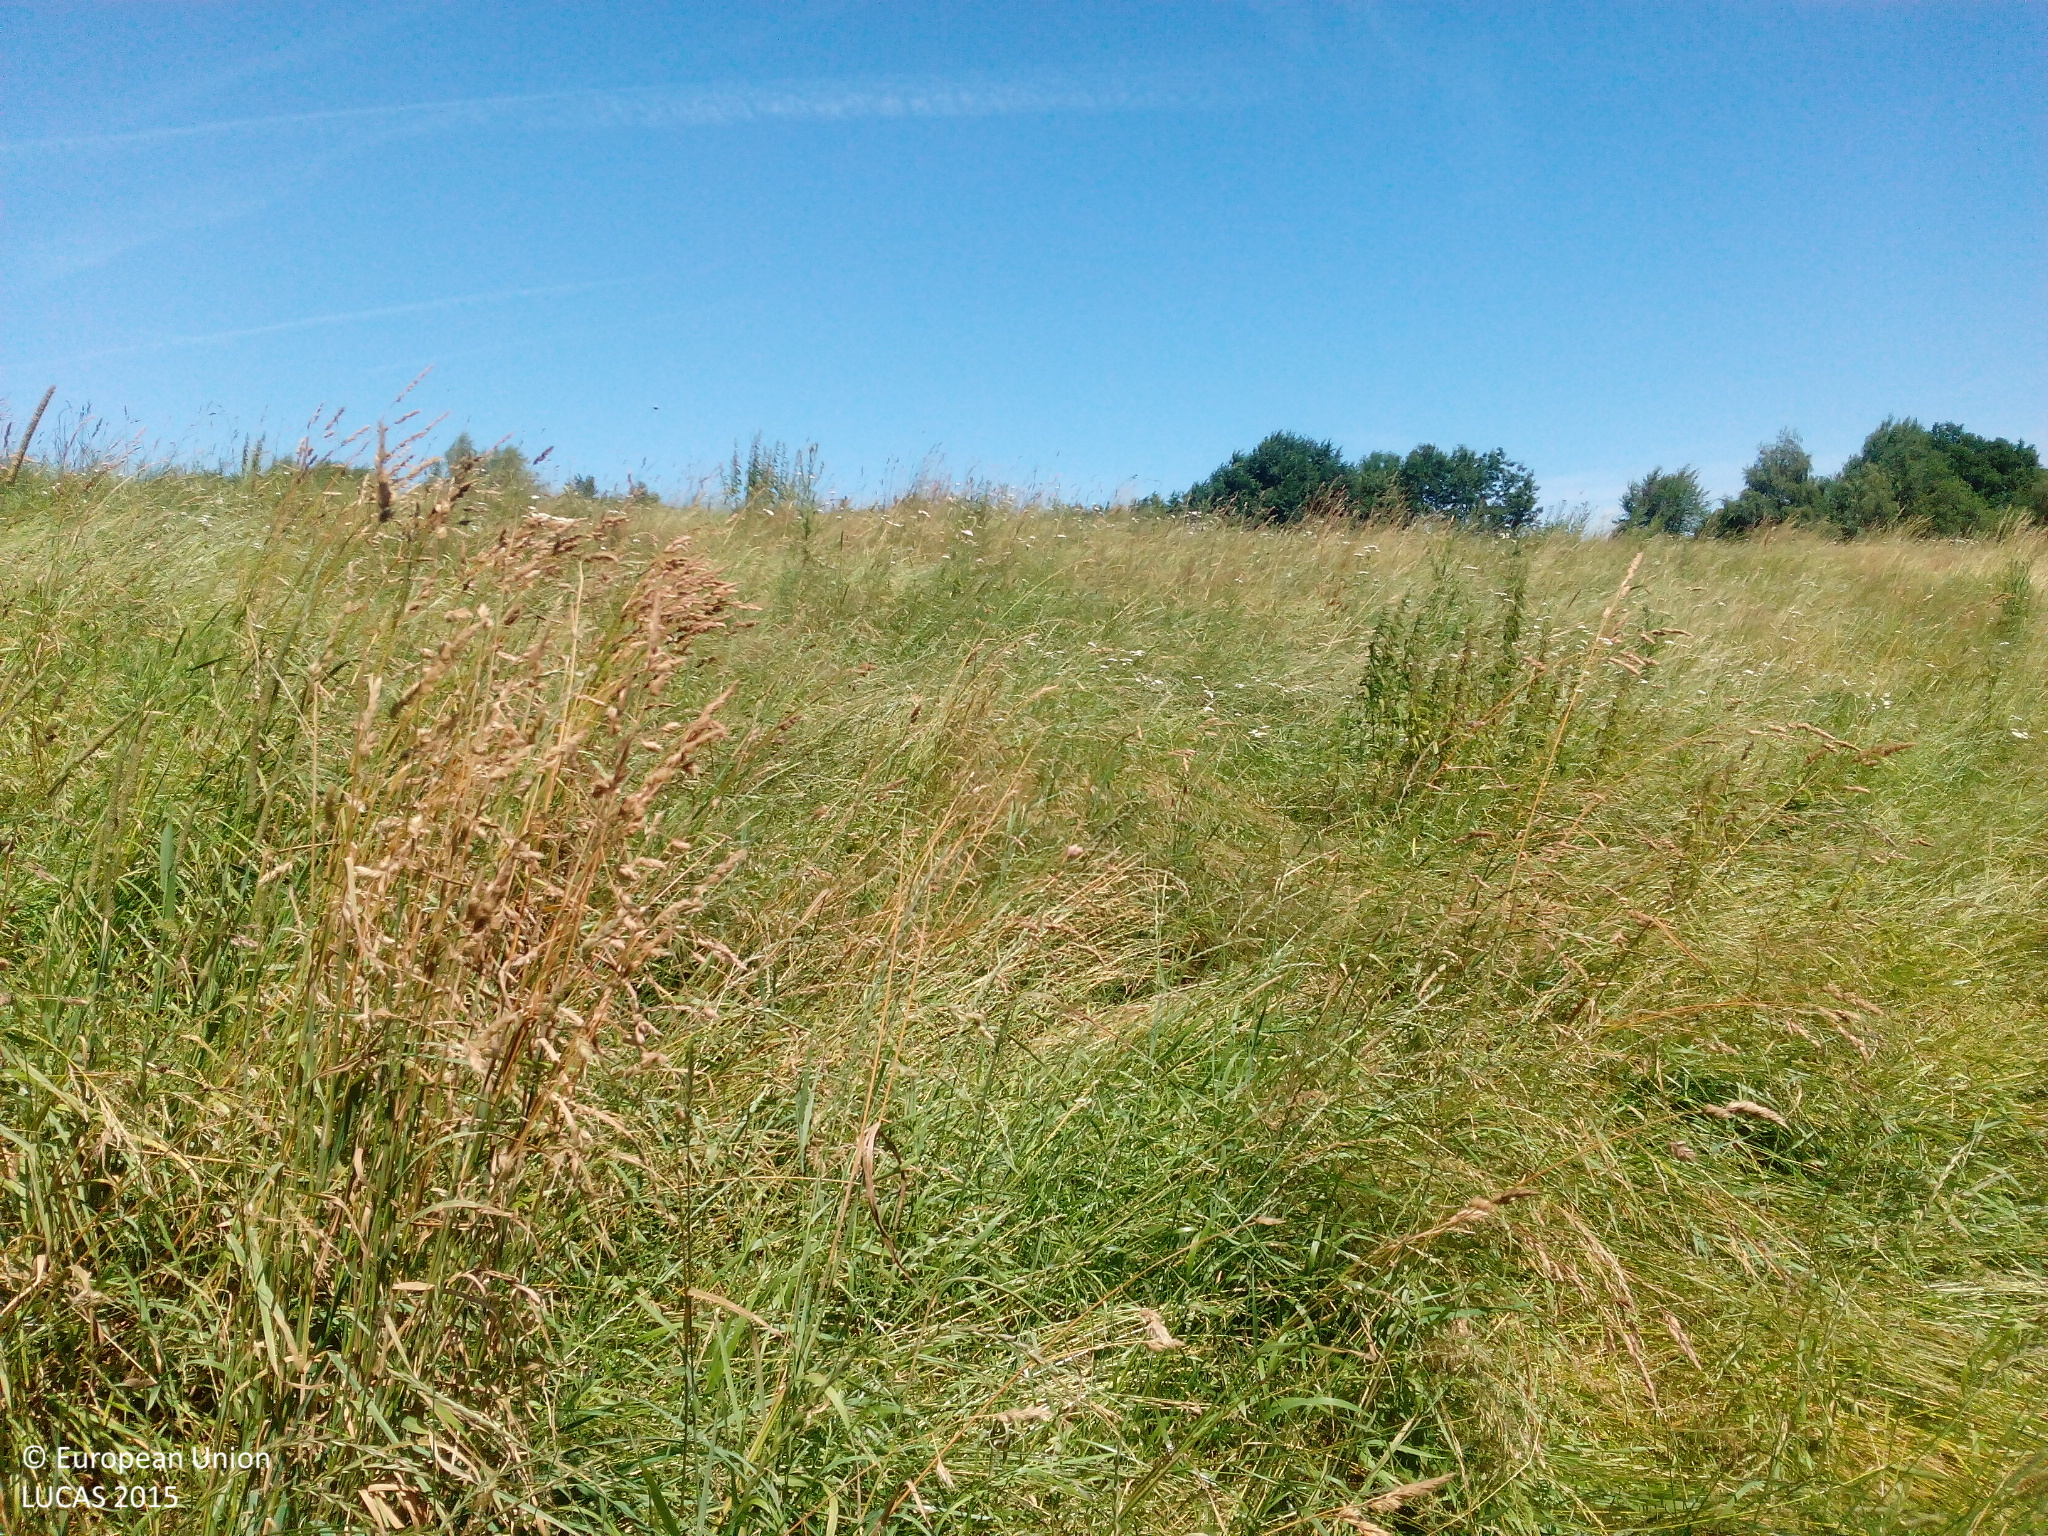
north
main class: Grassland
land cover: Grassland without tree/shrub cover
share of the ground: > 75 %
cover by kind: herbaceous plants 100 %
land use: Agriculture (excluding fallow land and kitchen gardens)
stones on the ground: < 10 %
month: July
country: DE
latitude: 49.7671
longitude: 12.2071
